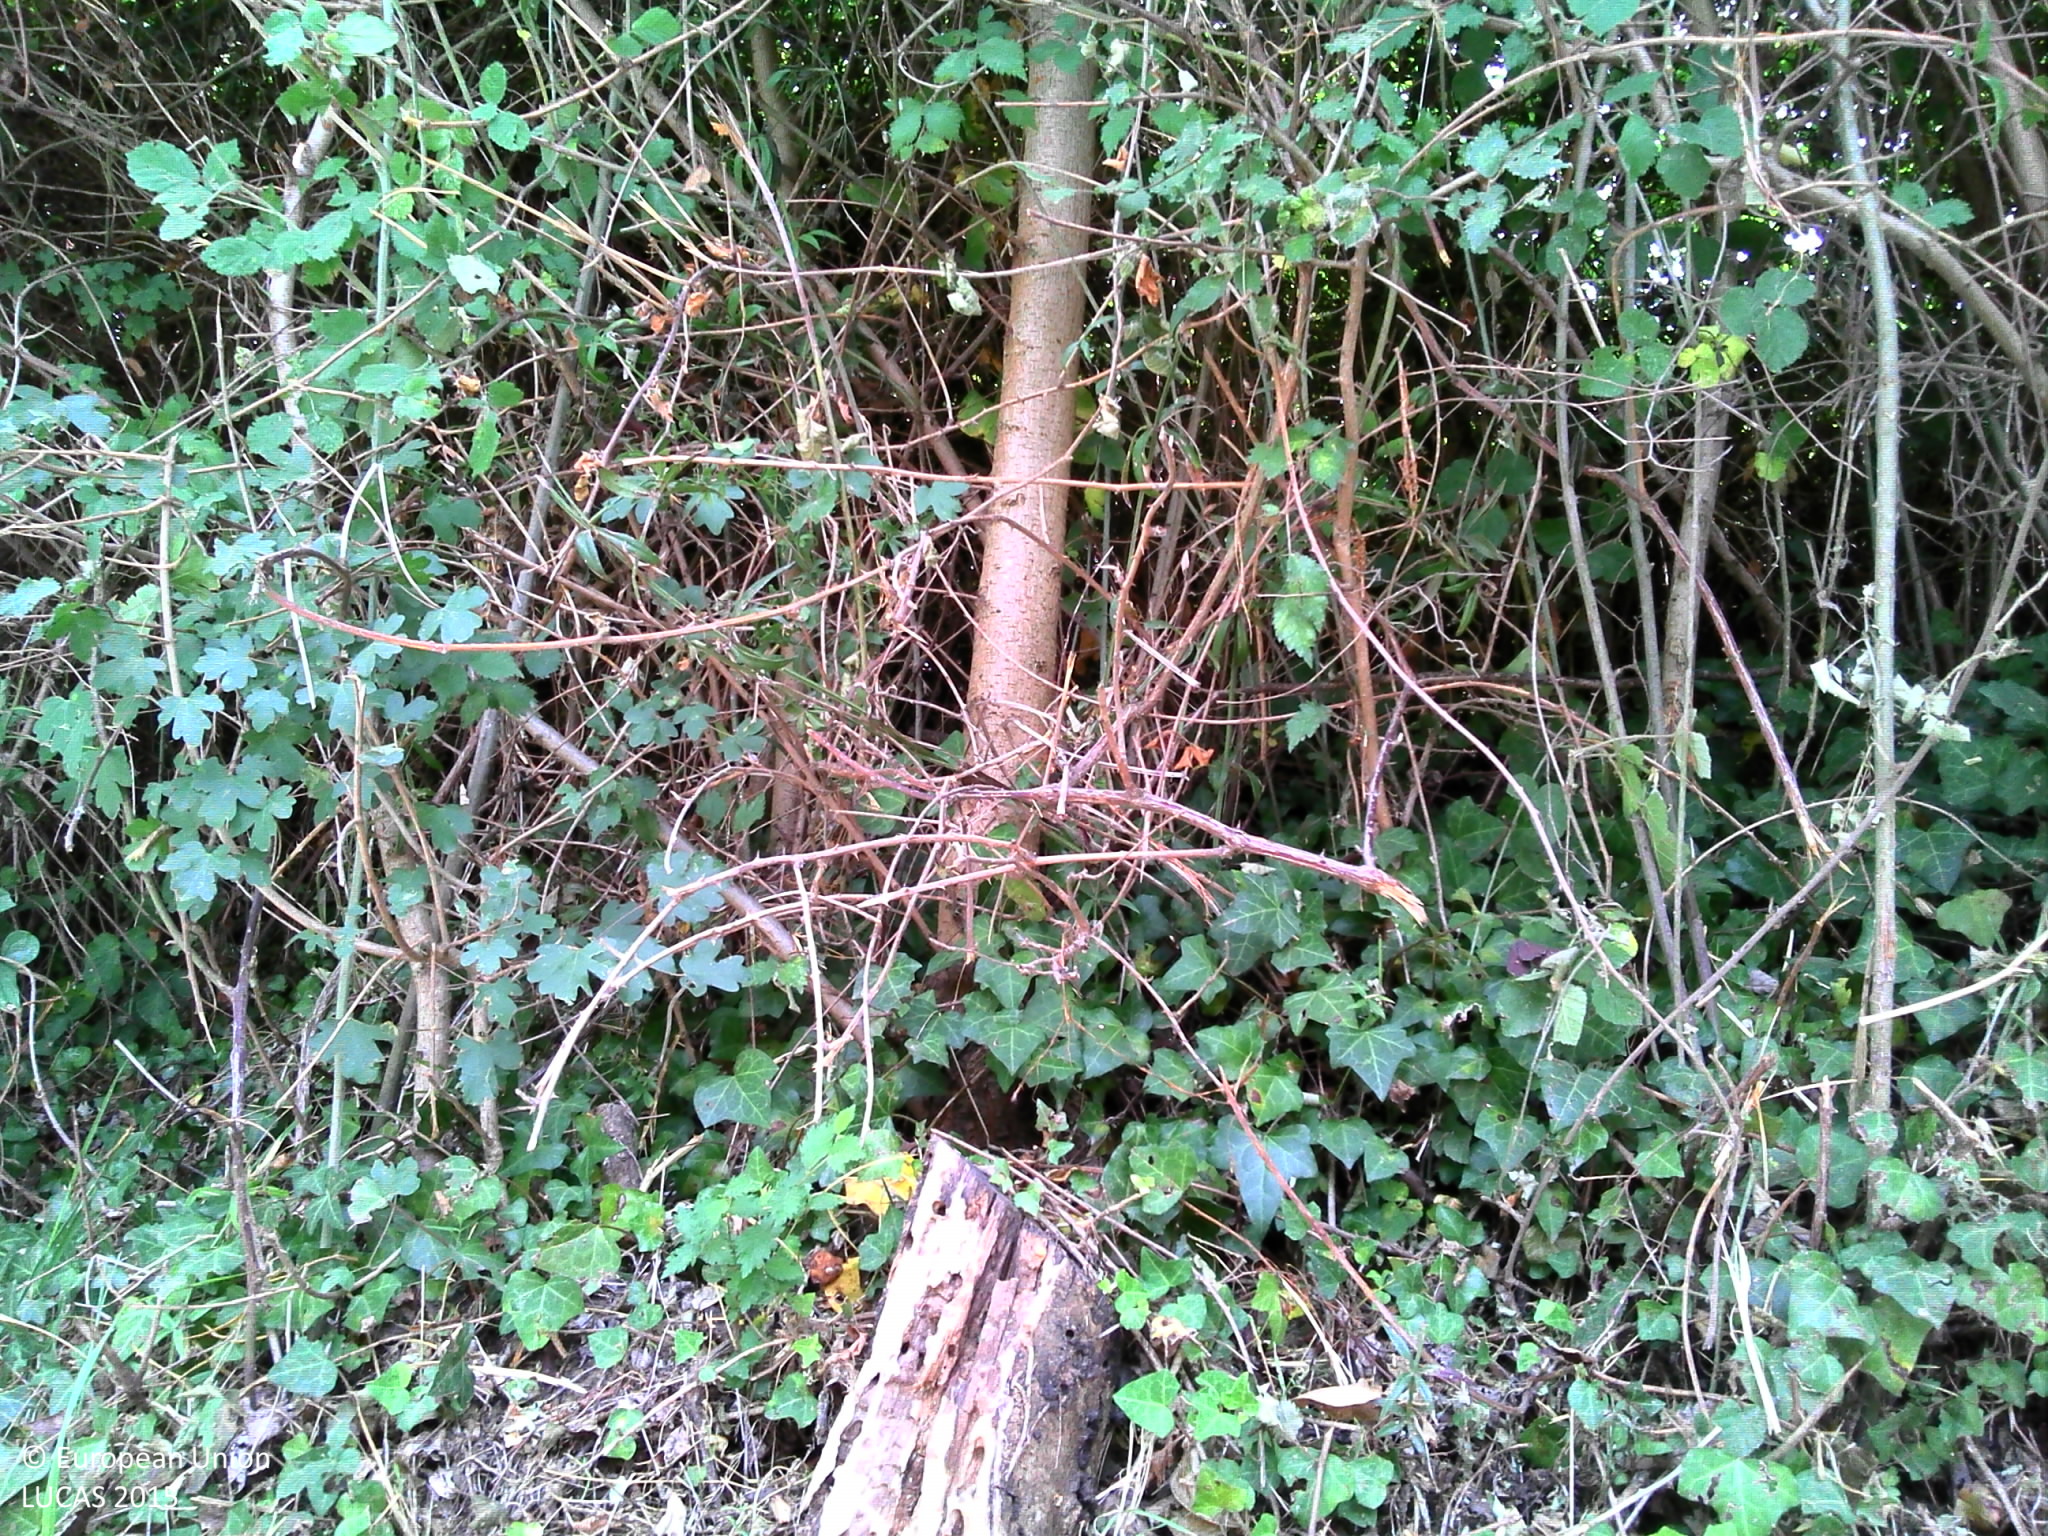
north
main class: Shrubland
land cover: Shrubland with sparse tree cover
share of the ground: > 75 %
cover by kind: shrubs 80 %, herbaceous plants 15 %, broadleaved forest trees 5 %
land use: Semi-natural and natural areas not in use
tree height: < 5 m
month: July
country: FR
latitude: 43.0502
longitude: 0.7827
